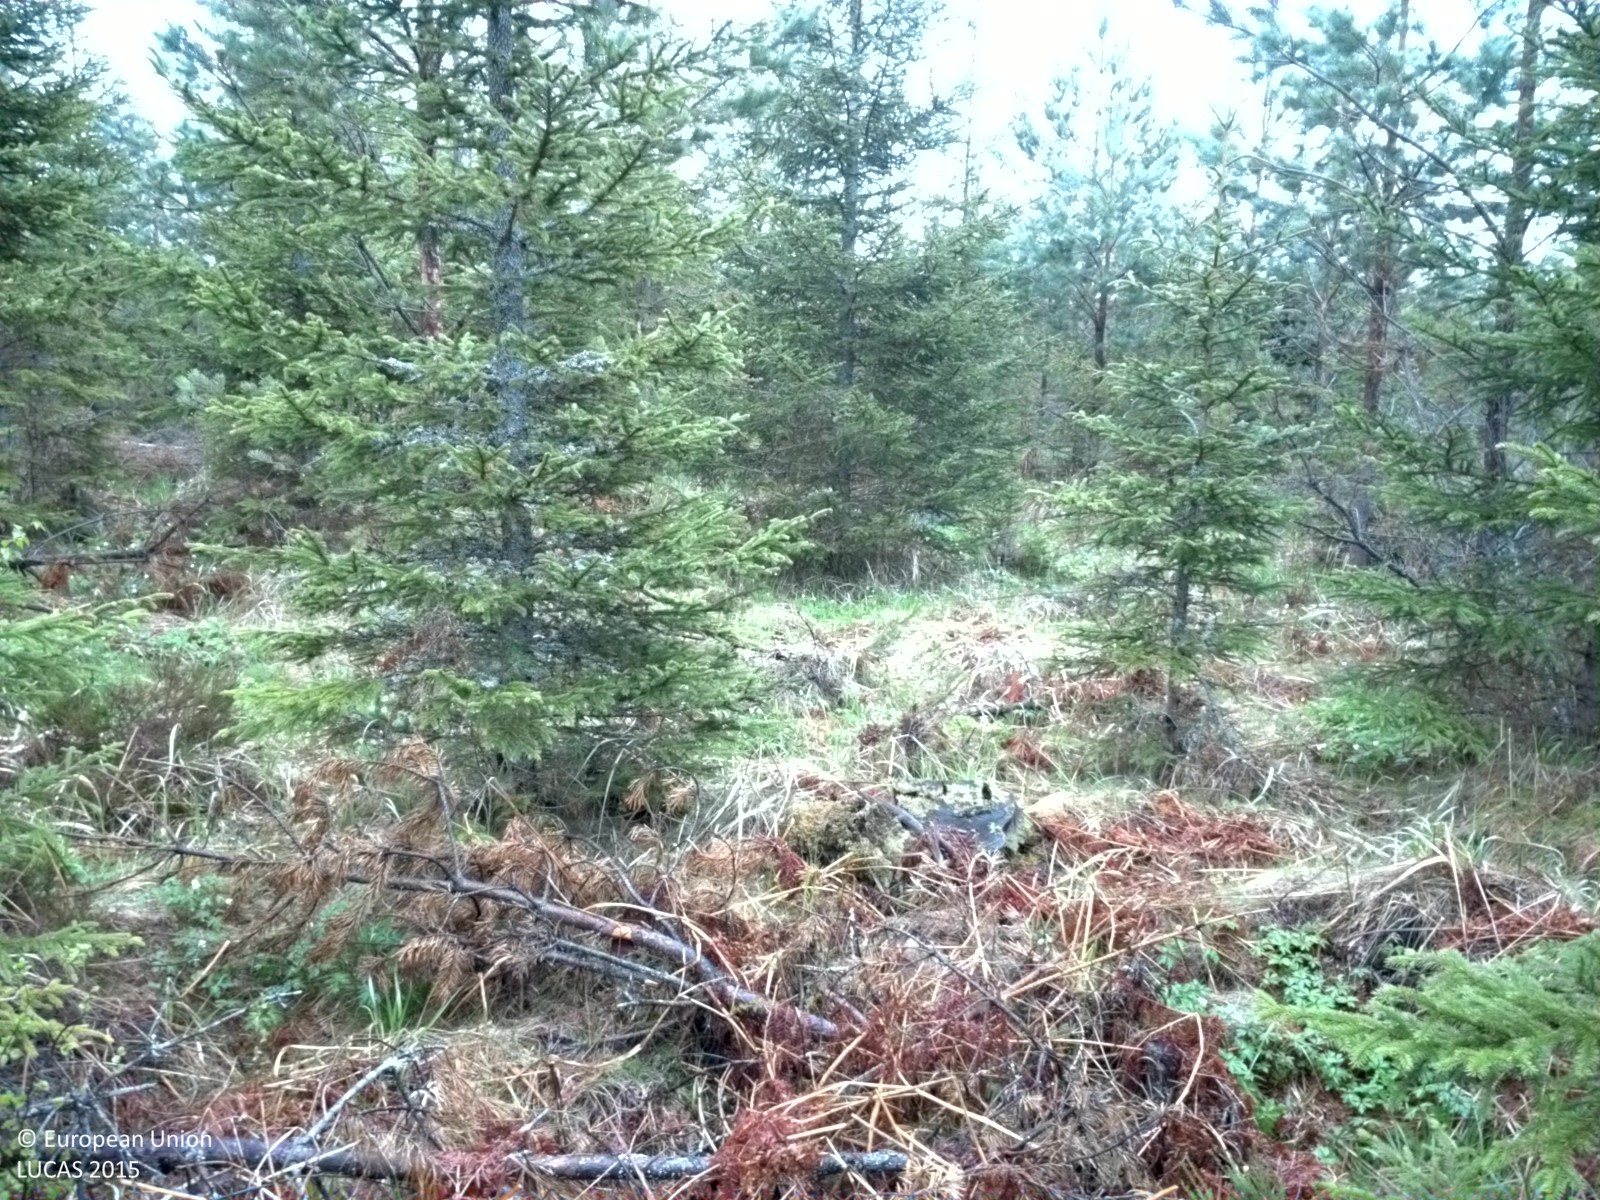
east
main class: Woodland
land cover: Spruce dominated coniferous woodland
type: boreal forest
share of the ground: > 75 %
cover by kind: coniferous forest trees 75 %, broadleaved forest trees 10 %, herbaceous plants 10 %, shrubs 5 %
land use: Forestry
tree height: > 5 m
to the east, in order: Spruce dominated coniferous woodland; Pine dominated coniferous woodland; Ditches and canals; Pine dominated coniferous woodland; Shrubland with sparse tree cover; Spruce dominated coniferous woodland
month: May
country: SE
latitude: 60.2035
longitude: 18.0588
